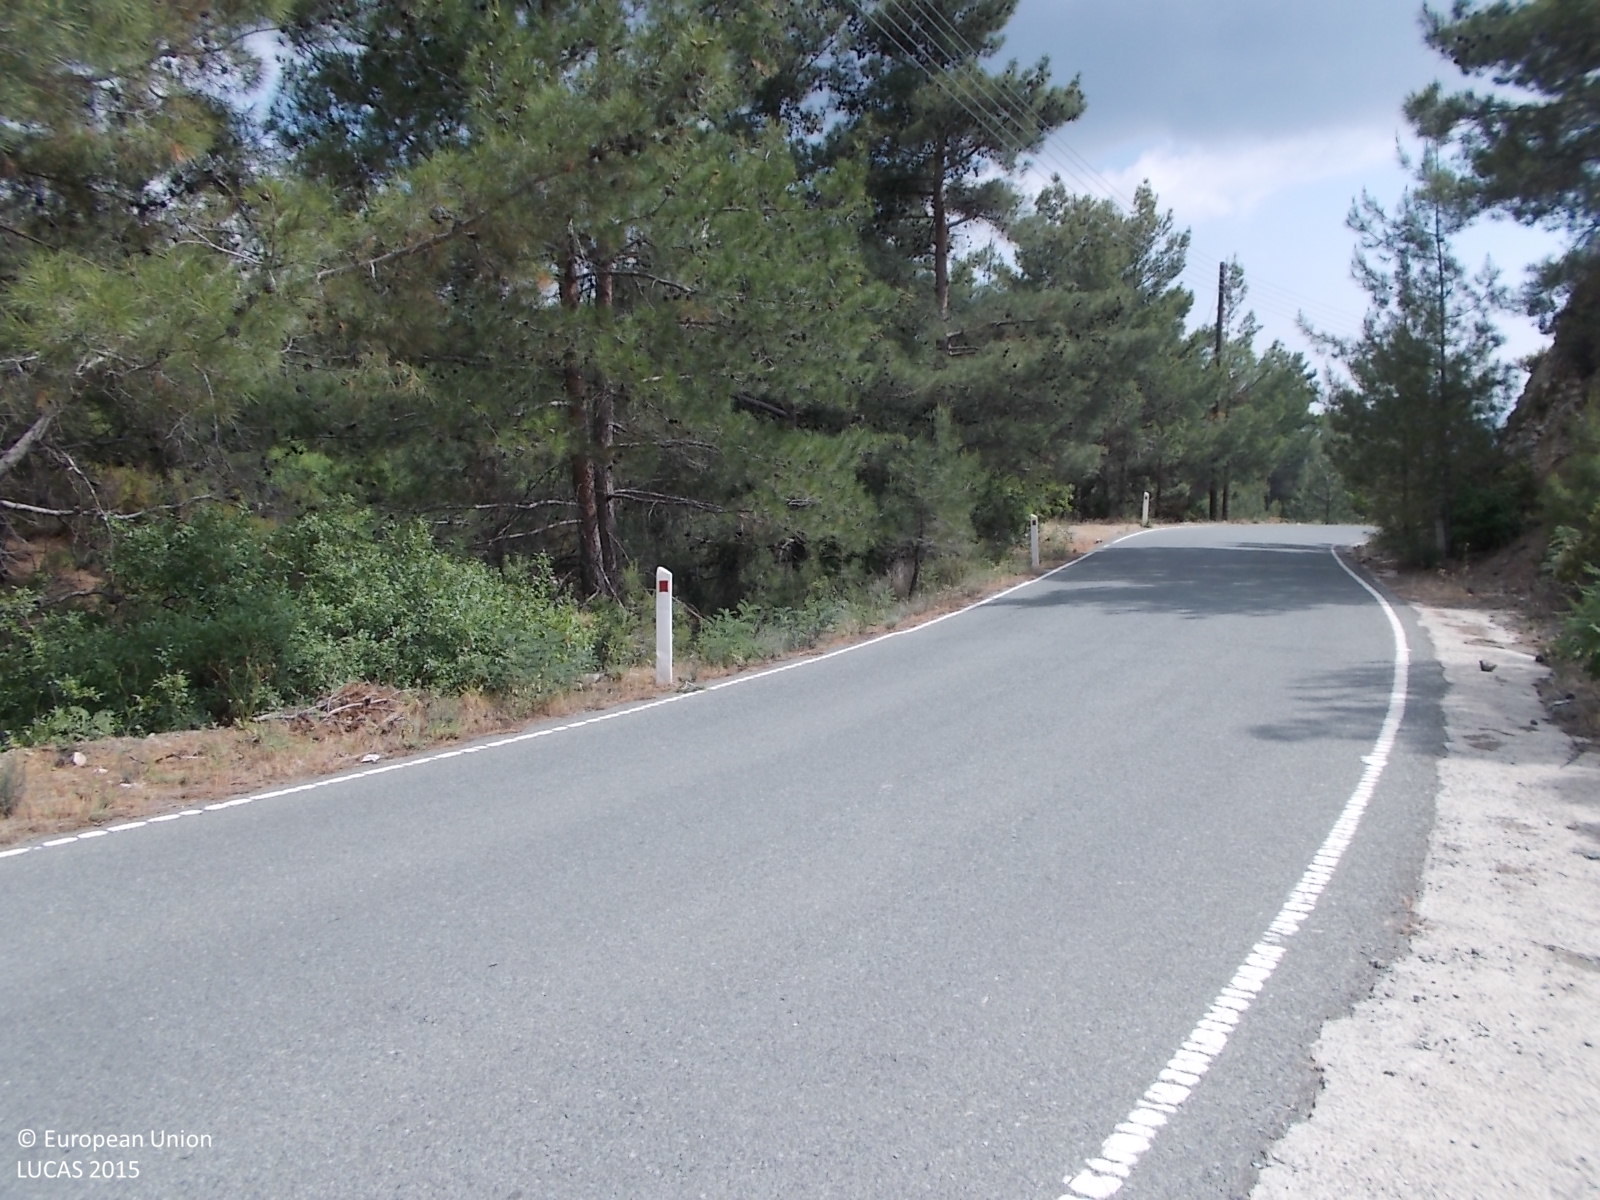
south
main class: Shrubland
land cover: Shrubland with sparse tree cover
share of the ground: 25 - 50 %
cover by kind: unconsolidated bare surface 50 %, shrubs 45 %, coniferous forest trees 5 %
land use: Semi-natural and natural areas not in use
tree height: > 5 m
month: June
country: CY
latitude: 34.8892
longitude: 32.8471
